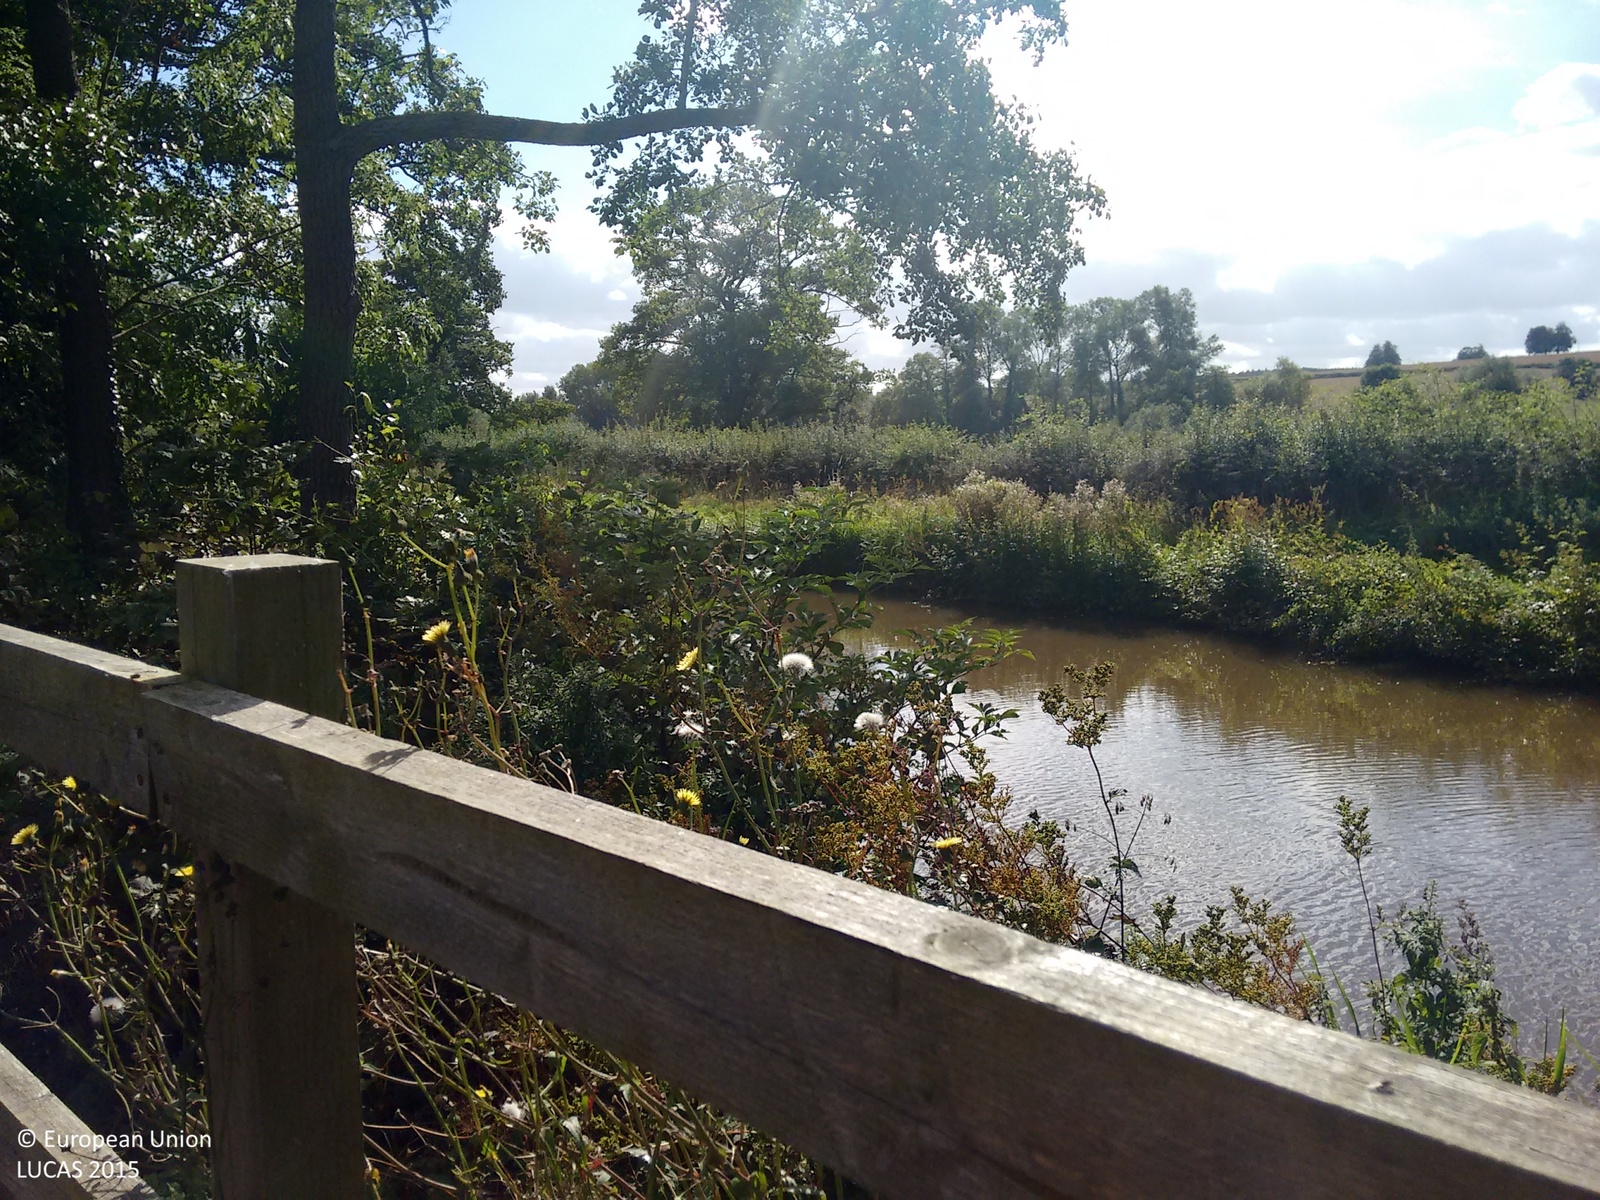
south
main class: Grassland
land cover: Grassland without tree/shrub cover
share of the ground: > 75 %
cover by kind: herbaceous plants 100 %
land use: Agriculture (excluding fallow land and kitchen gardens)
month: September
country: GB
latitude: 52.8351
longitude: -2.0378
